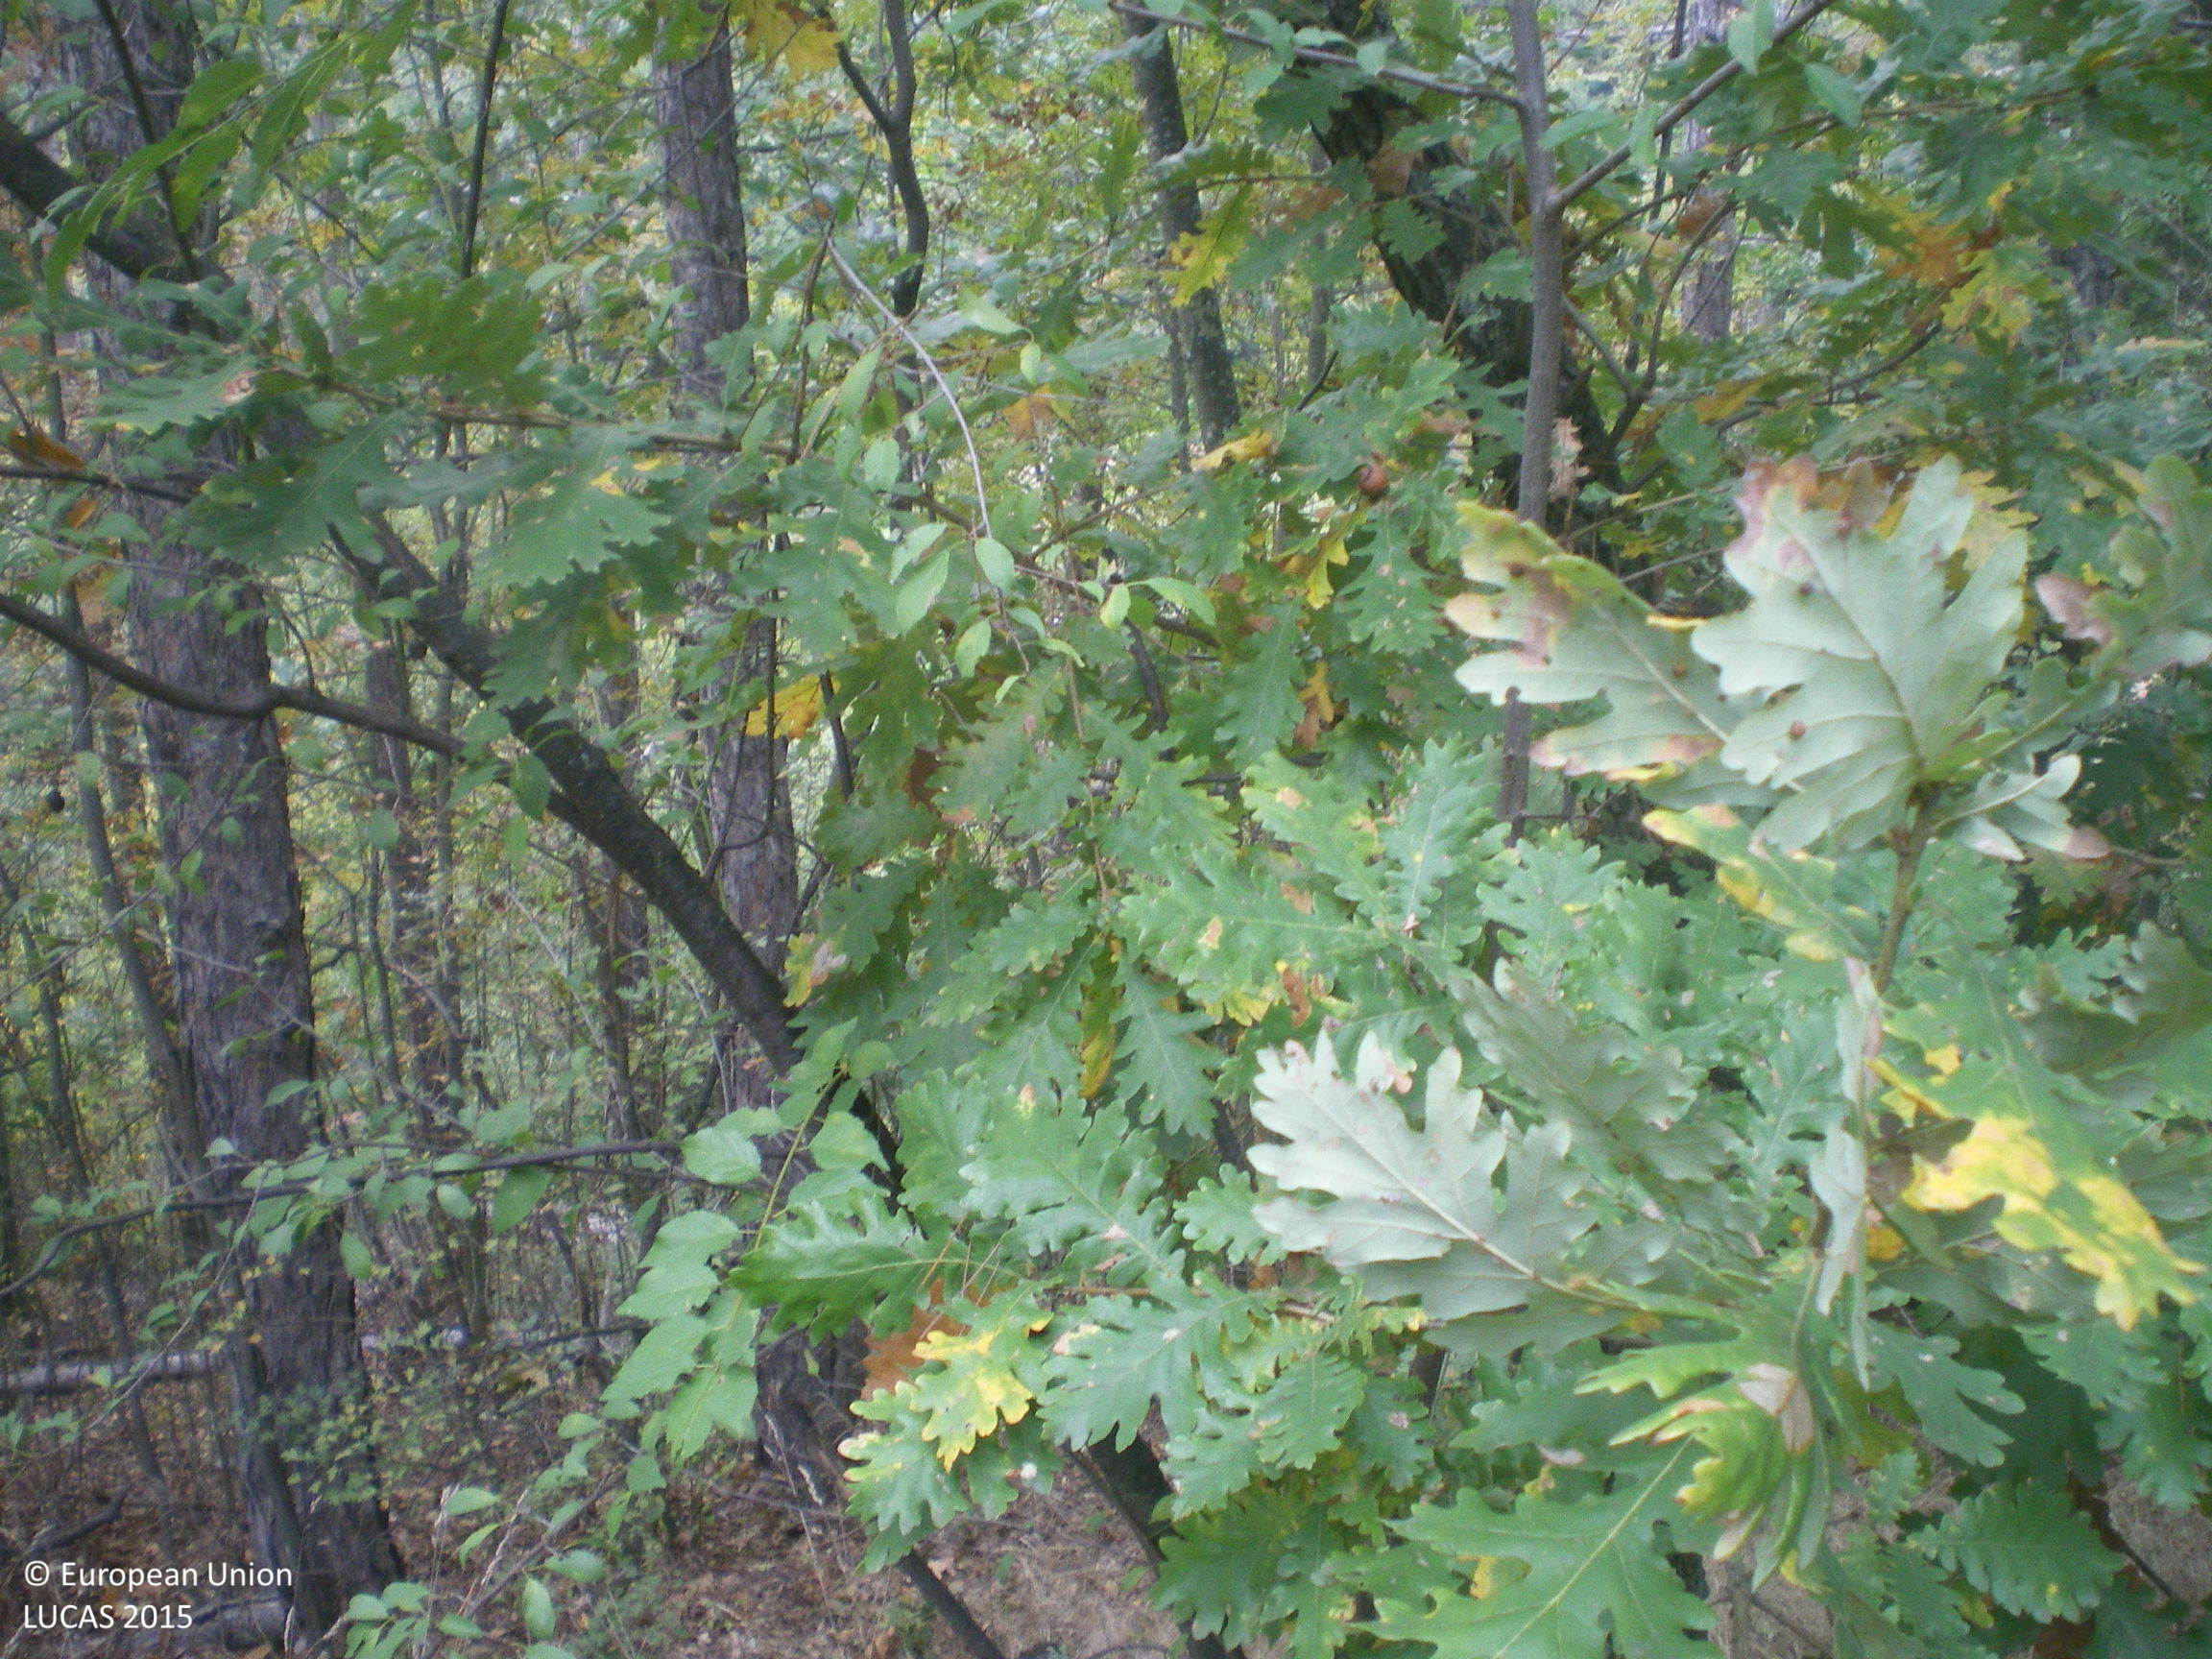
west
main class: Woodland
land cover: Other mixed woodland
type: hemiboreal forest and nemoral coniferous forest and mixed broadleaved-coniferous forest
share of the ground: > 75 %
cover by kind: coniferous forest trees 65 %, broadleaved forest trees 25 %, shrubs 10 %
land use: Forestry
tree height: > 5 m
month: October
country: BG
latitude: 42.6758
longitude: 25.6585
